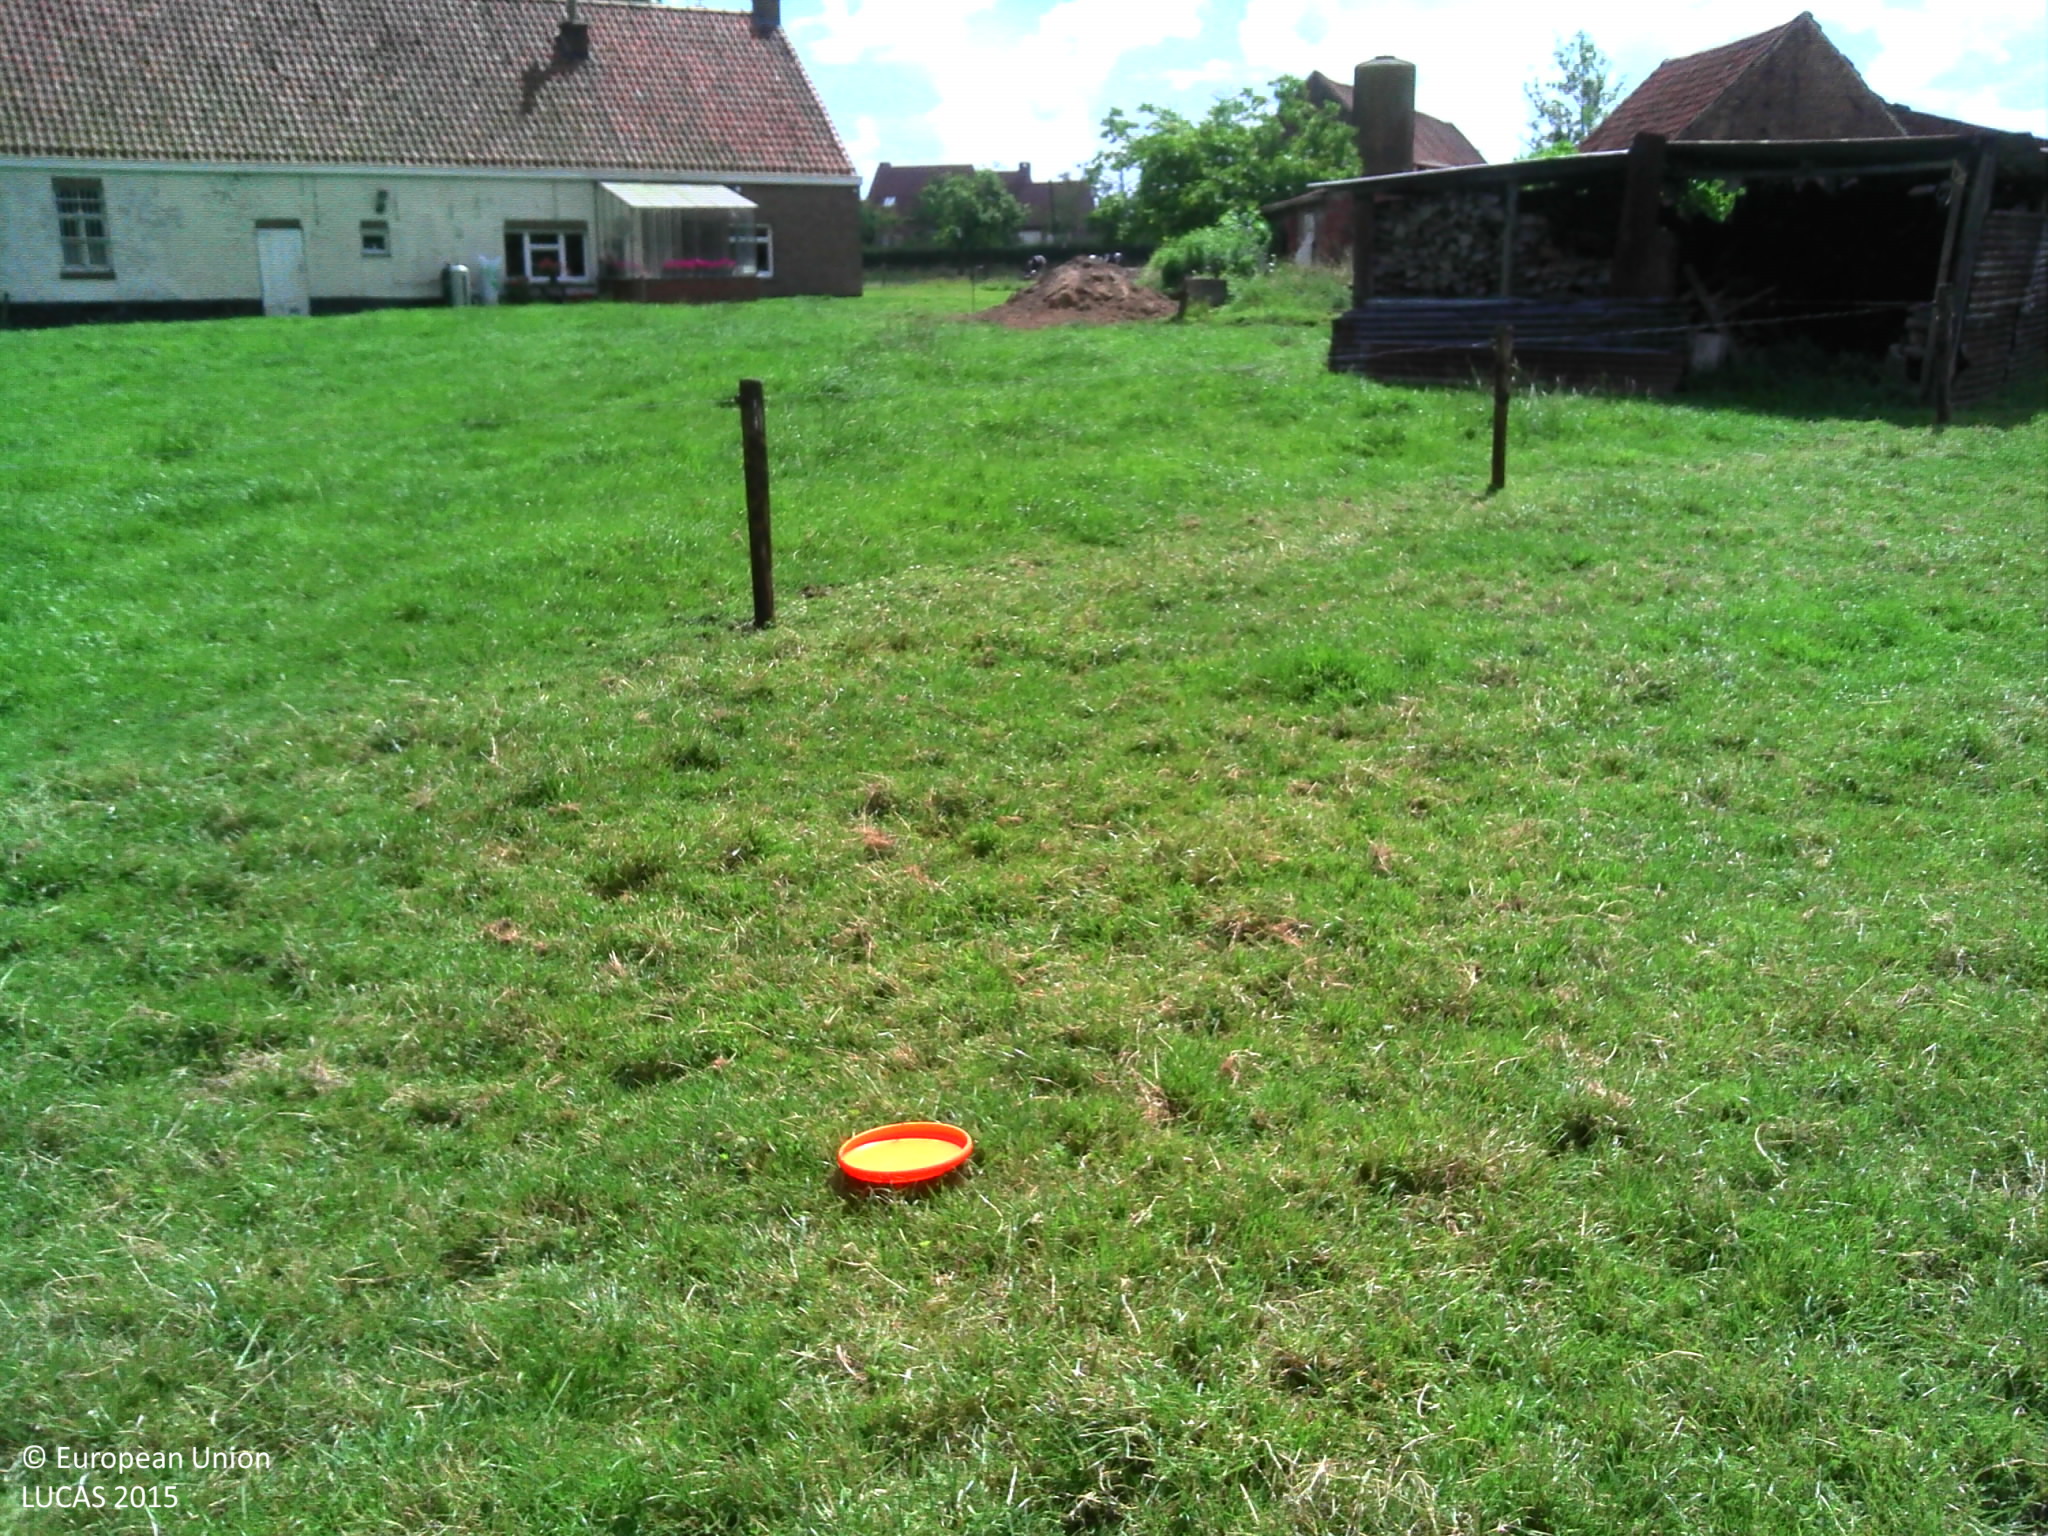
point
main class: Grassland
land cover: Grassland without tree/shrub cover
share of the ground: > 75 %
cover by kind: herbaceous plants 100 %
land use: Agriculture (excluding fallow land and kitchen gardens)
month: June
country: BE
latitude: 51.0678
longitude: 3.5850
